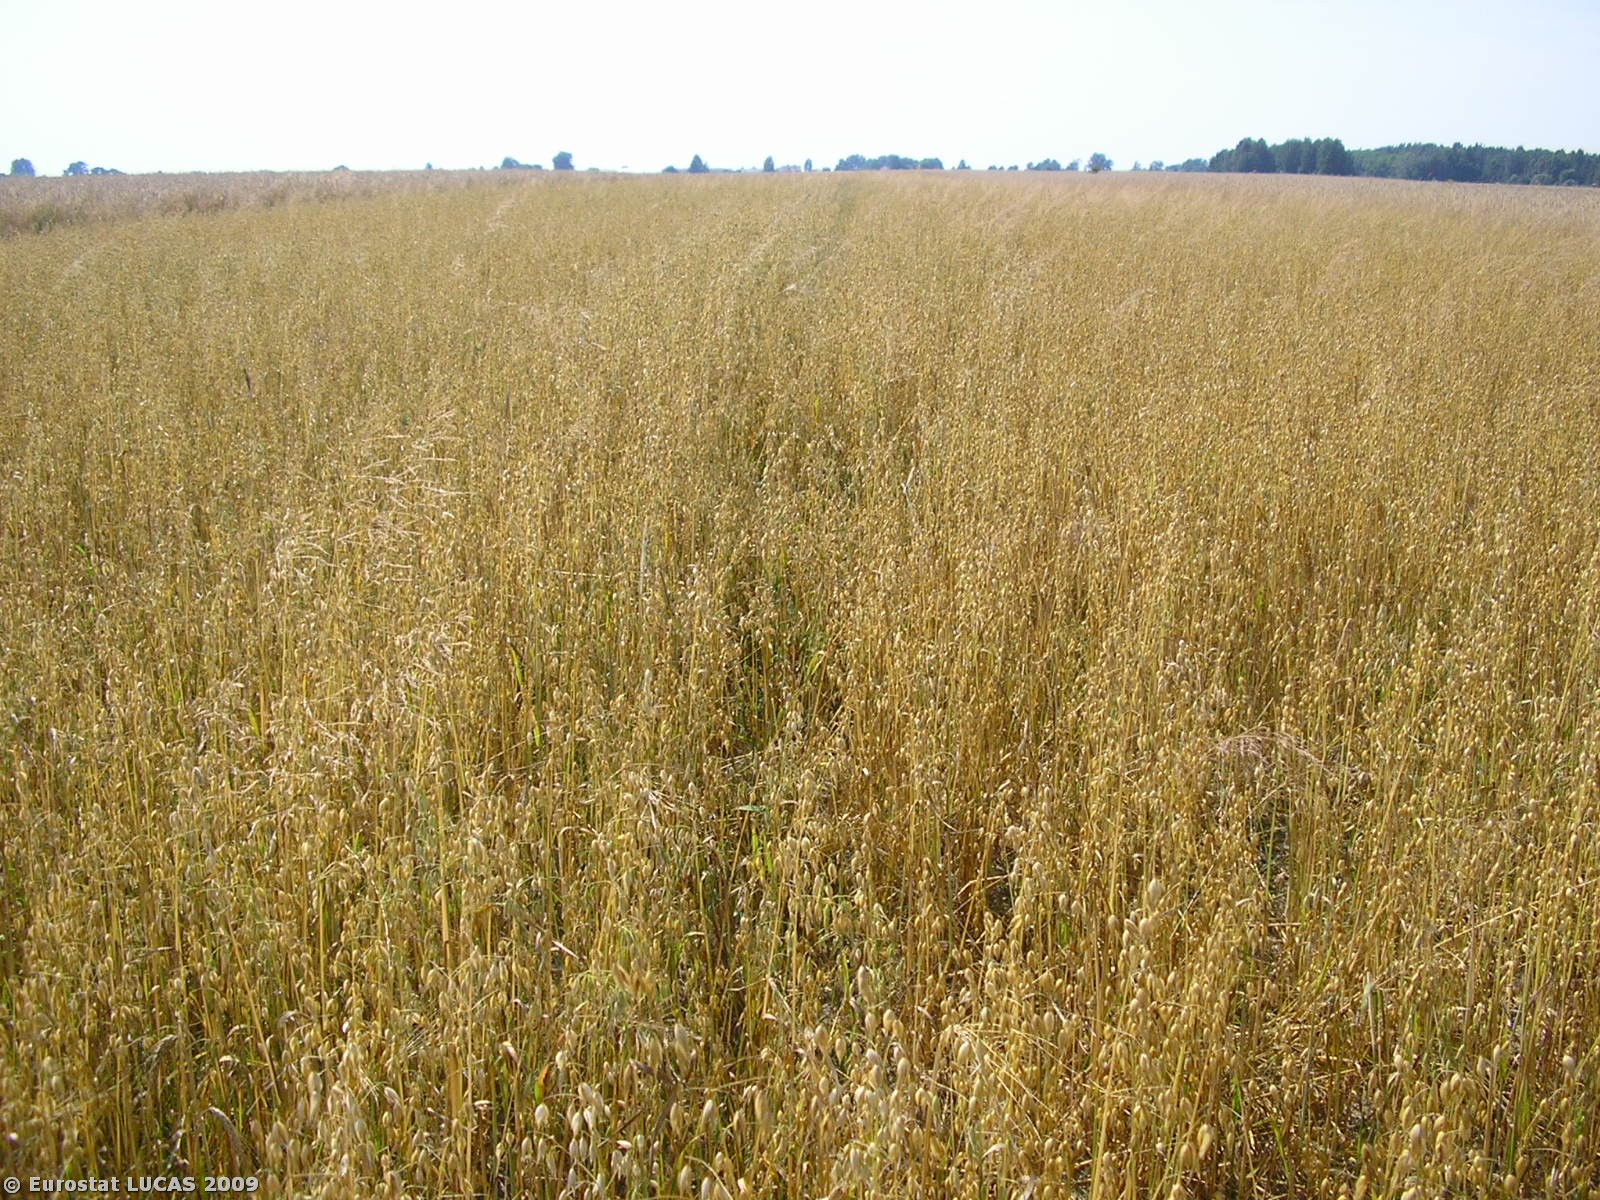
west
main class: Cropland
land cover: Oats
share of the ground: > 75 %
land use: Agriculture (excluding fallow land and kitchen gardens)
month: July
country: PL
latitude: 52.0712
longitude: 22.2145
